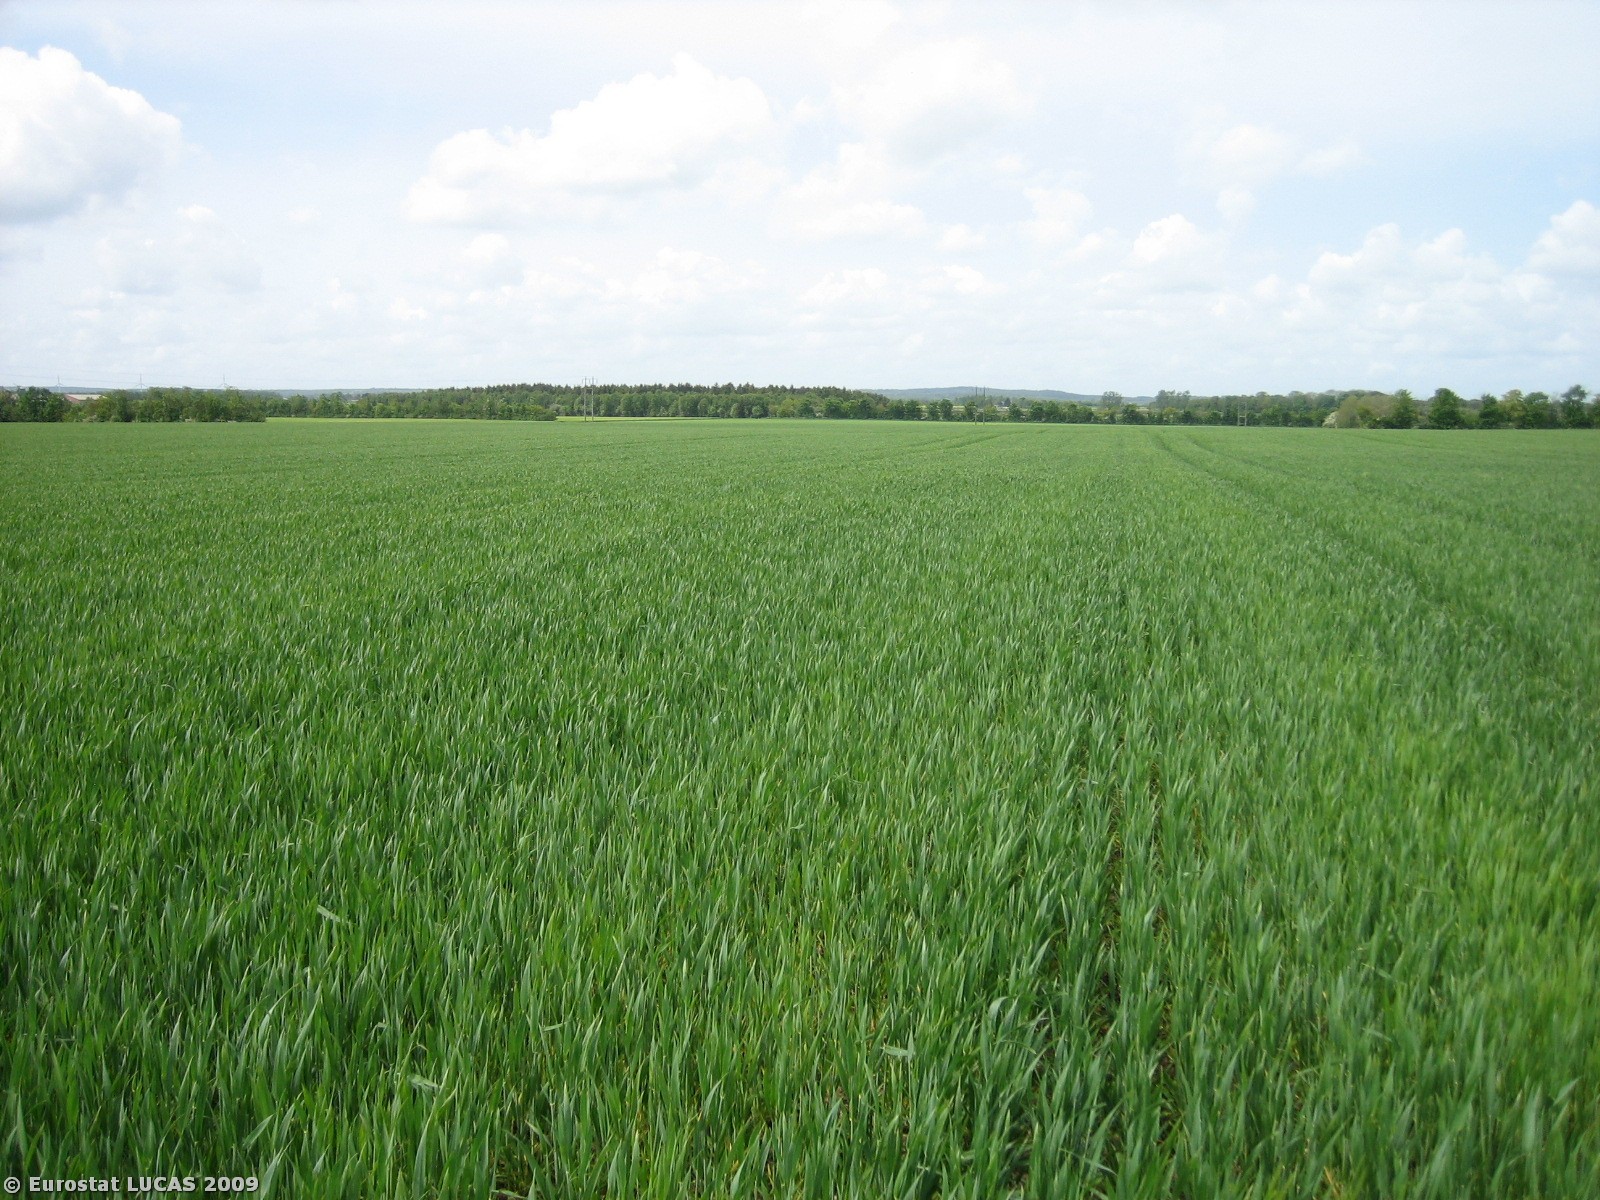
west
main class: Cropland
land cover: Common wheat
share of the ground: > 75 %
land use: Agriculture (excluding fallow land and kitchen gardens)
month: May
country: DK
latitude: 56.2180
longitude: 8.7920
